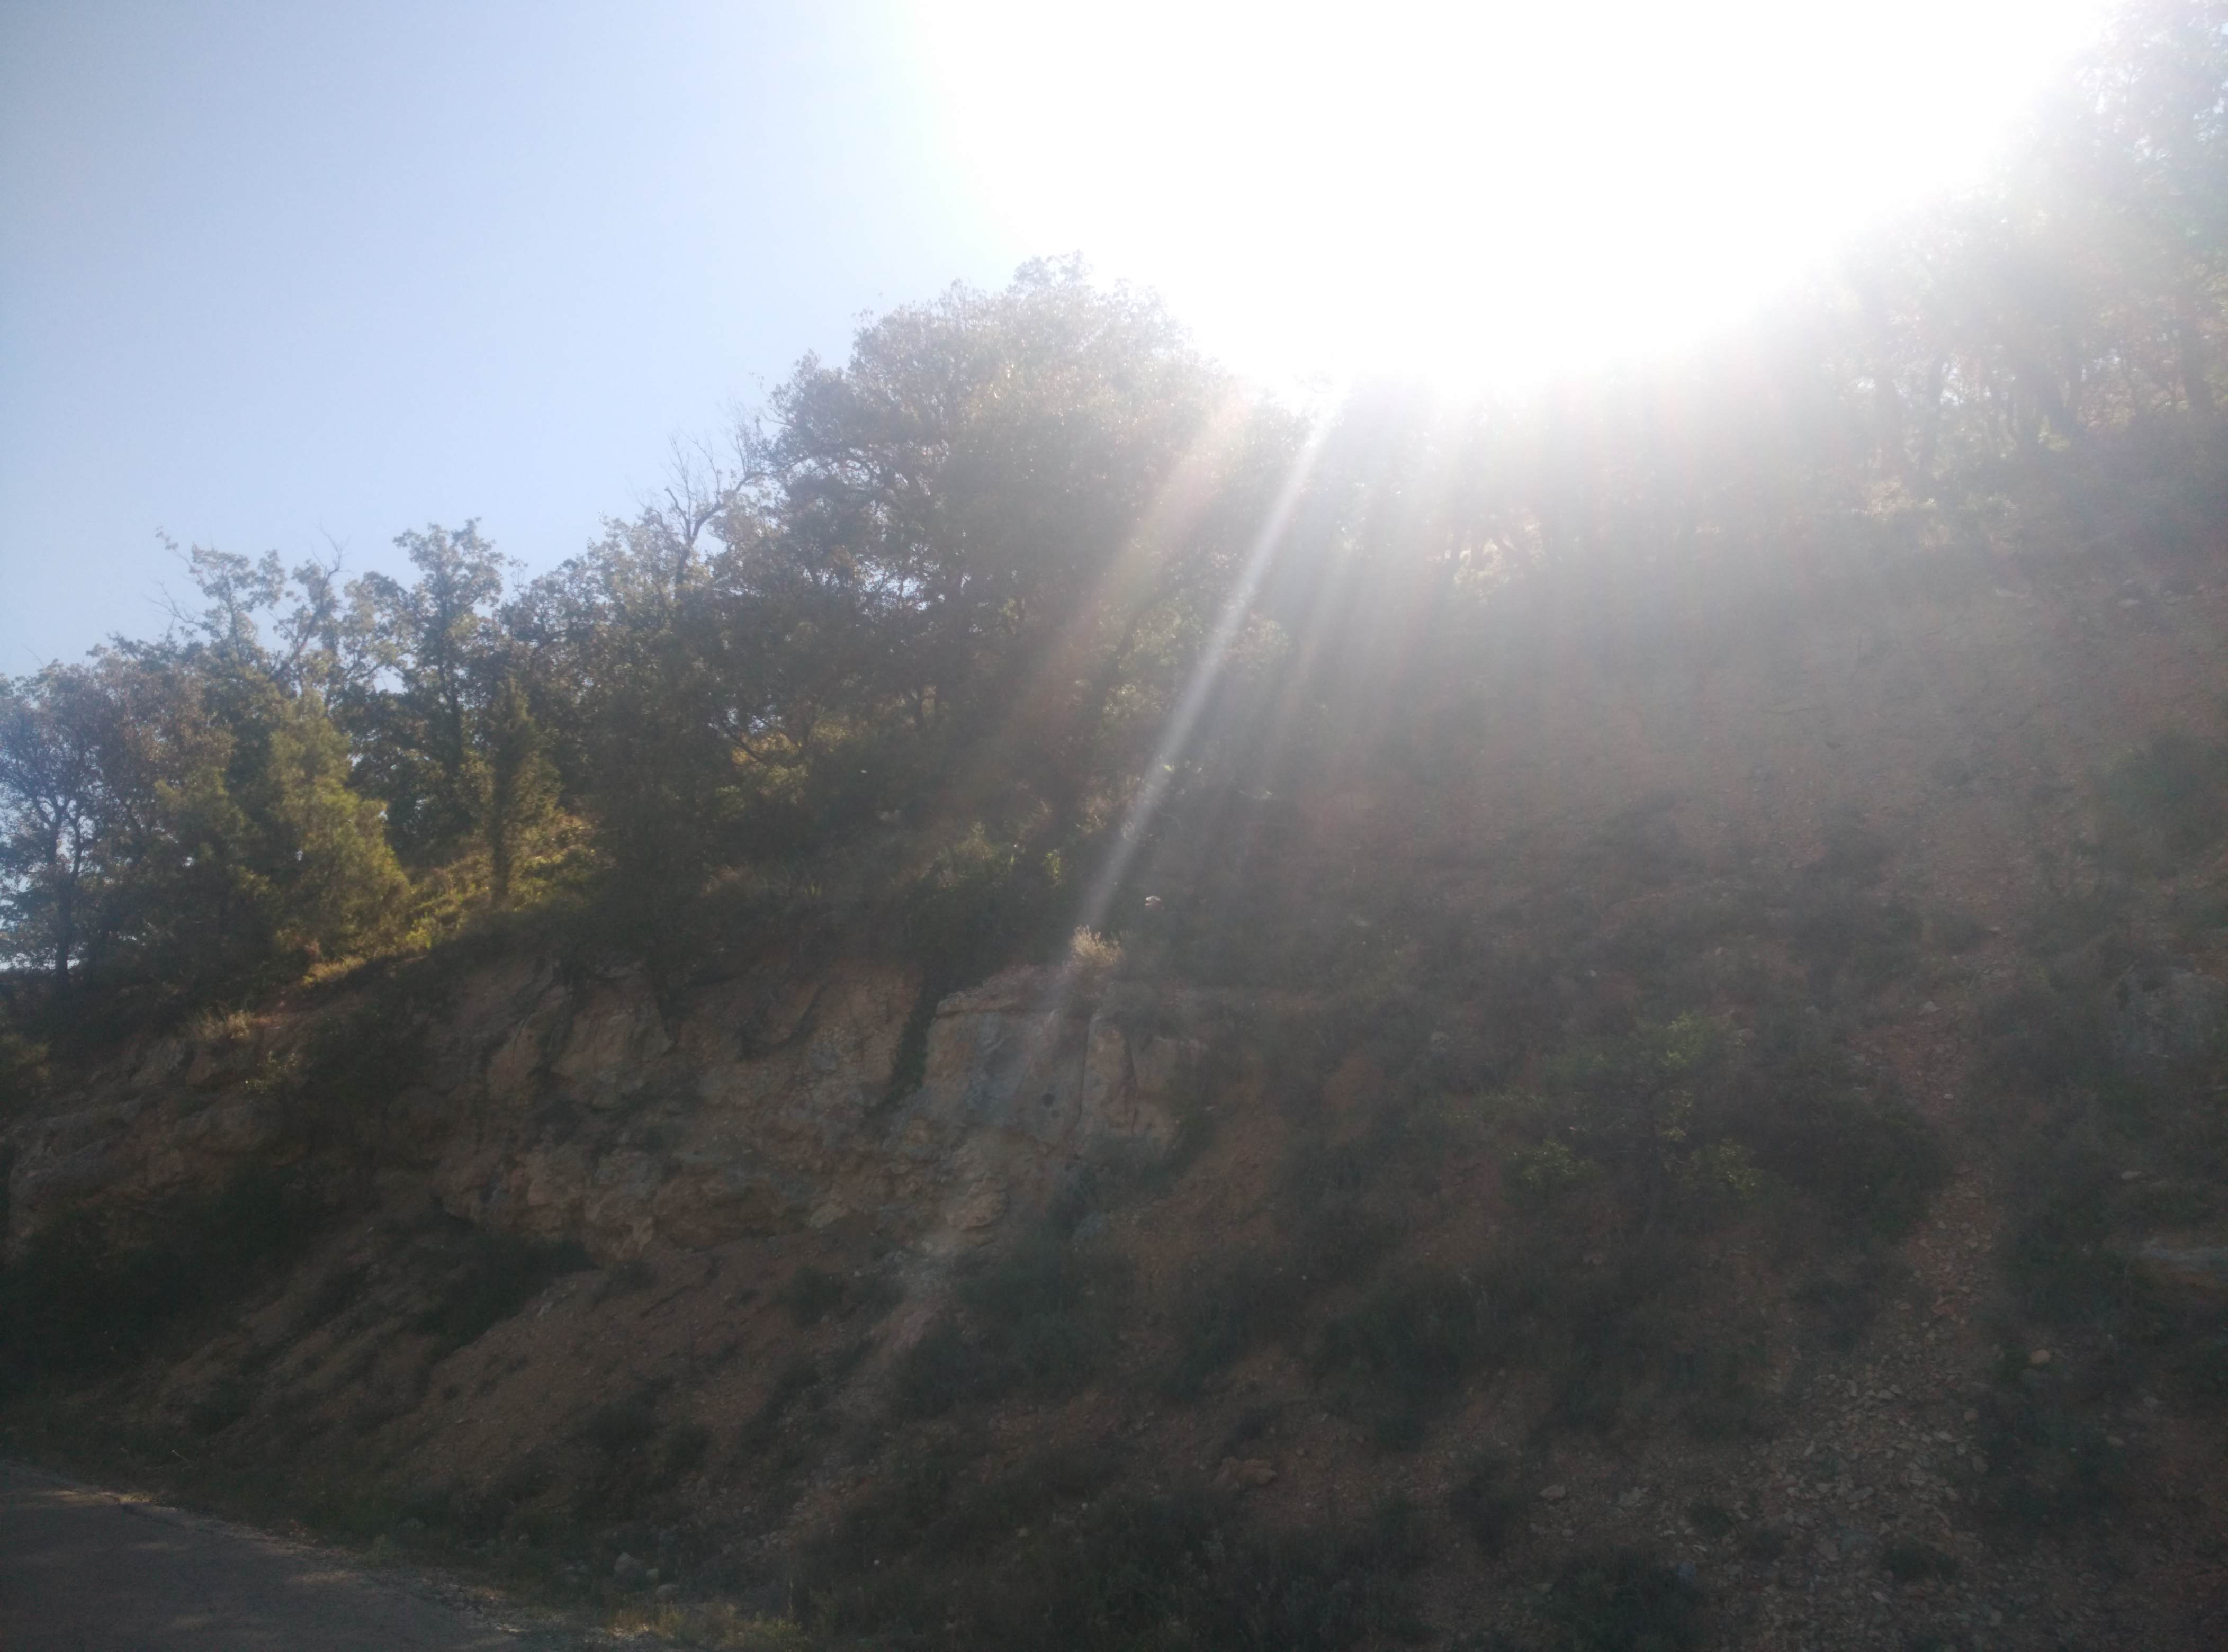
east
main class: Woodland
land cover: Broadleaved woodland
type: thermophilous deciduous forest
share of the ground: 50 - 75 %
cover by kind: broadleaved forest trees 60 %, unconsolidated bare surface 30 %, shrubs 10 %
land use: Semi-natural and natural areas not in use
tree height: > 5 m
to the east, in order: Broadleaved woodland
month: July
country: ES
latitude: 40.7169
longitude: -2.8512
